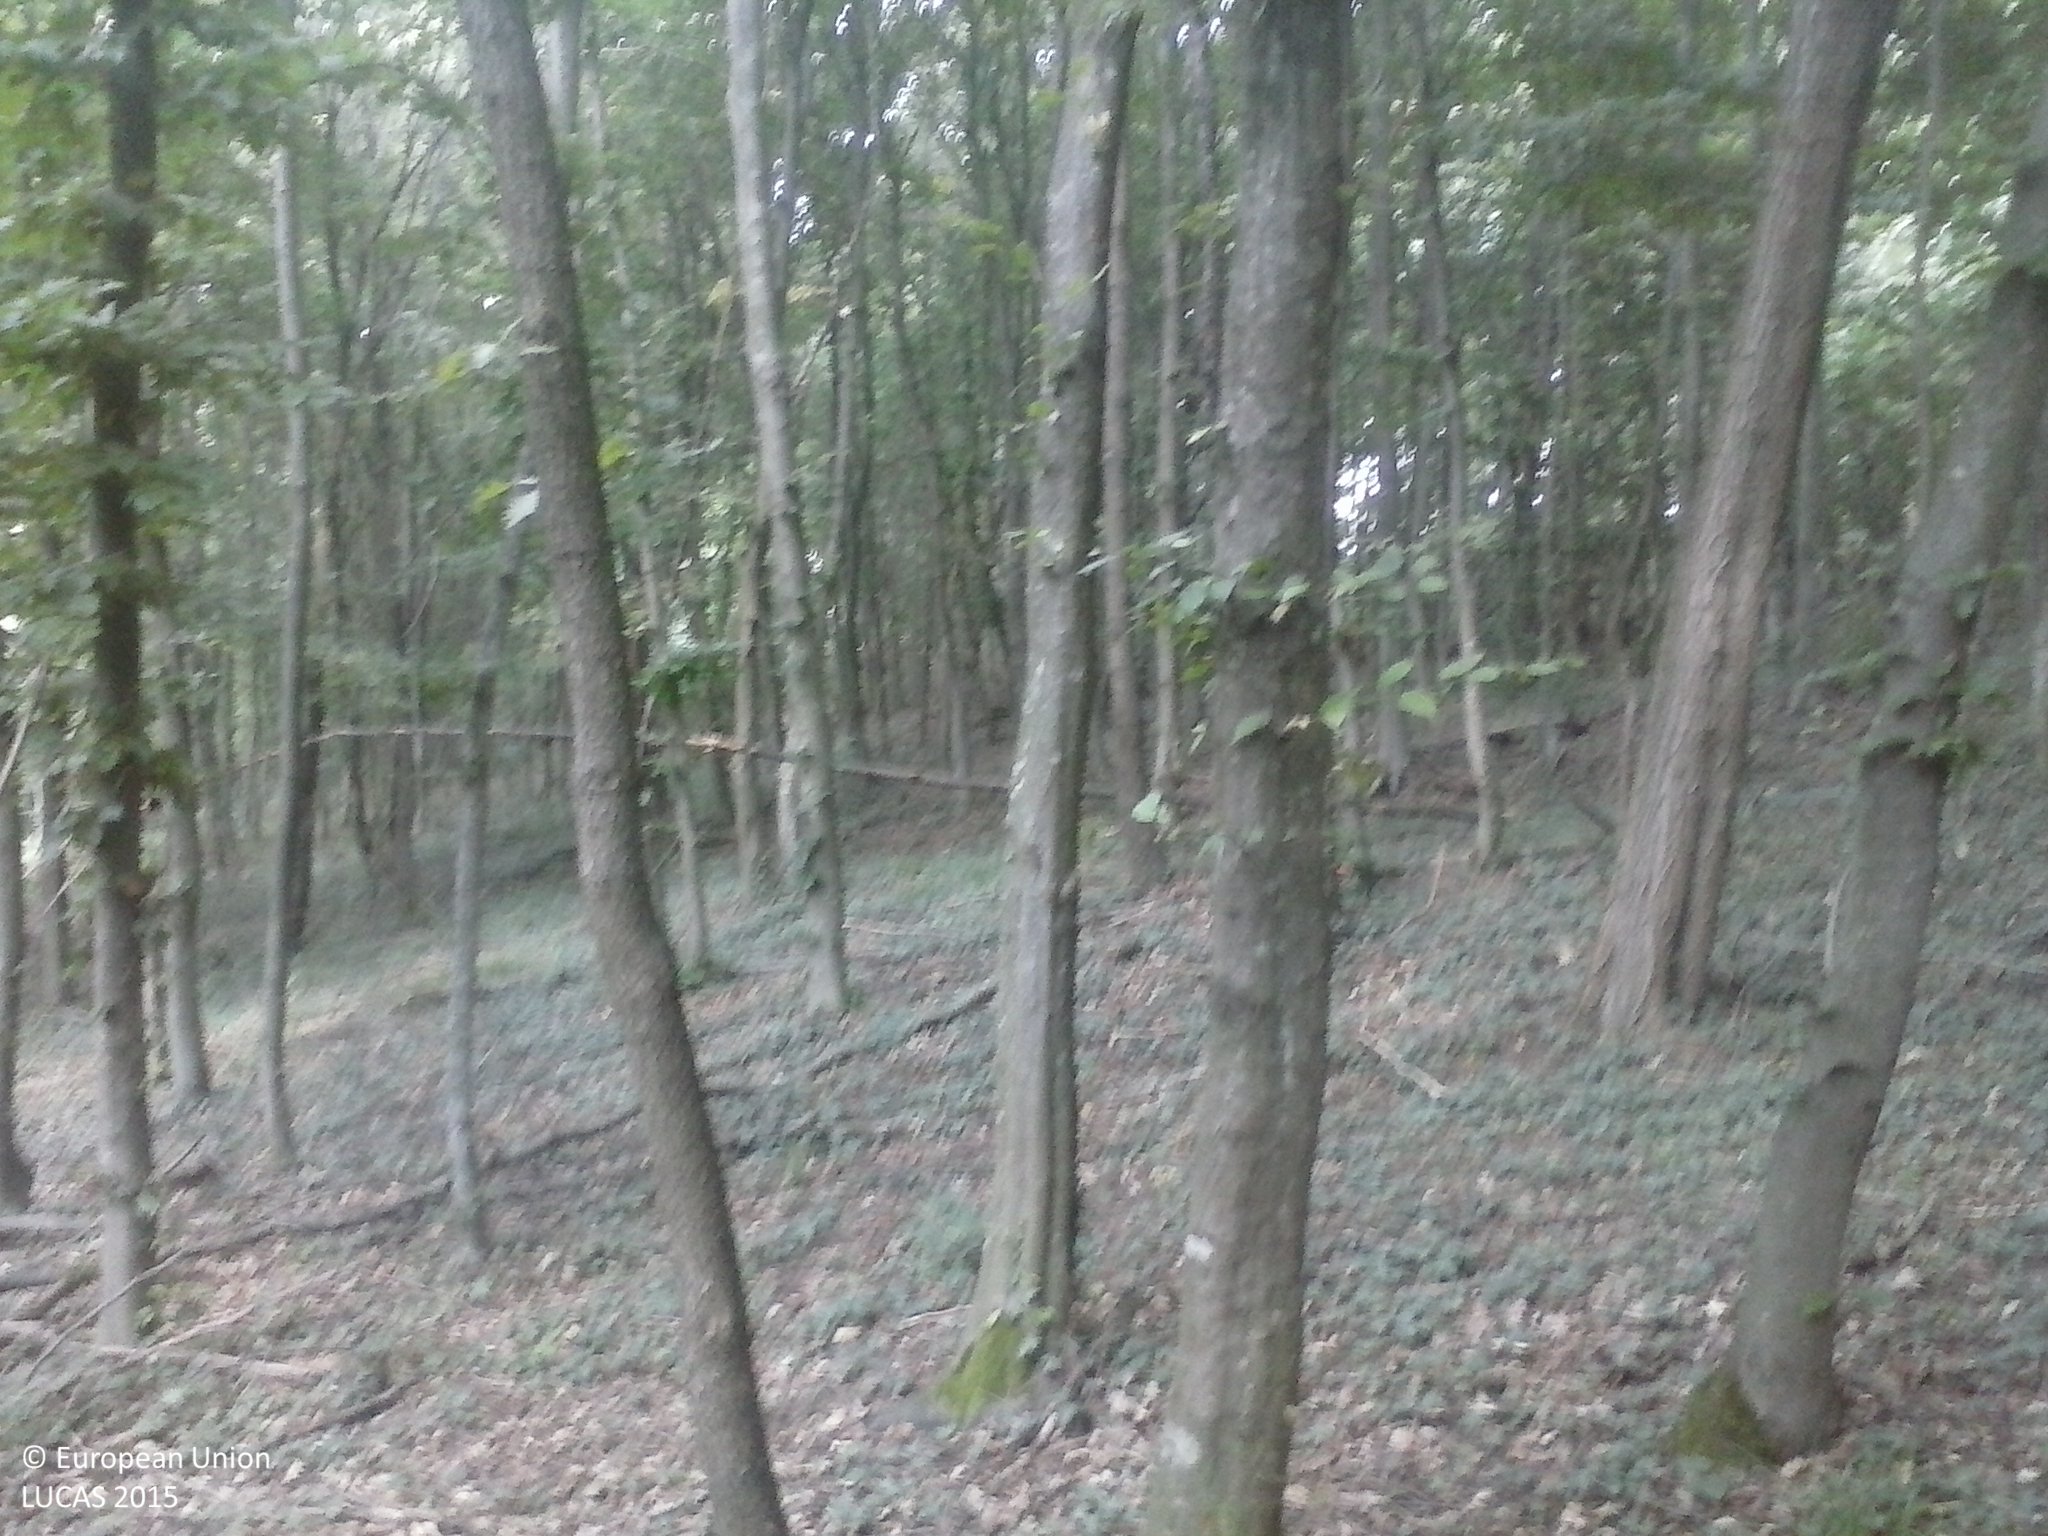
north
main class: Woodland
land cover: Broadleaved woodland
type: beech forest
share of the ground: > 75 %
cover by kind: broadleaved forest trees 100 %
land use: Forestry
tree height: > 5 m
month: August
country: HU
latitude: 46.1198
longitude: 17.8082
